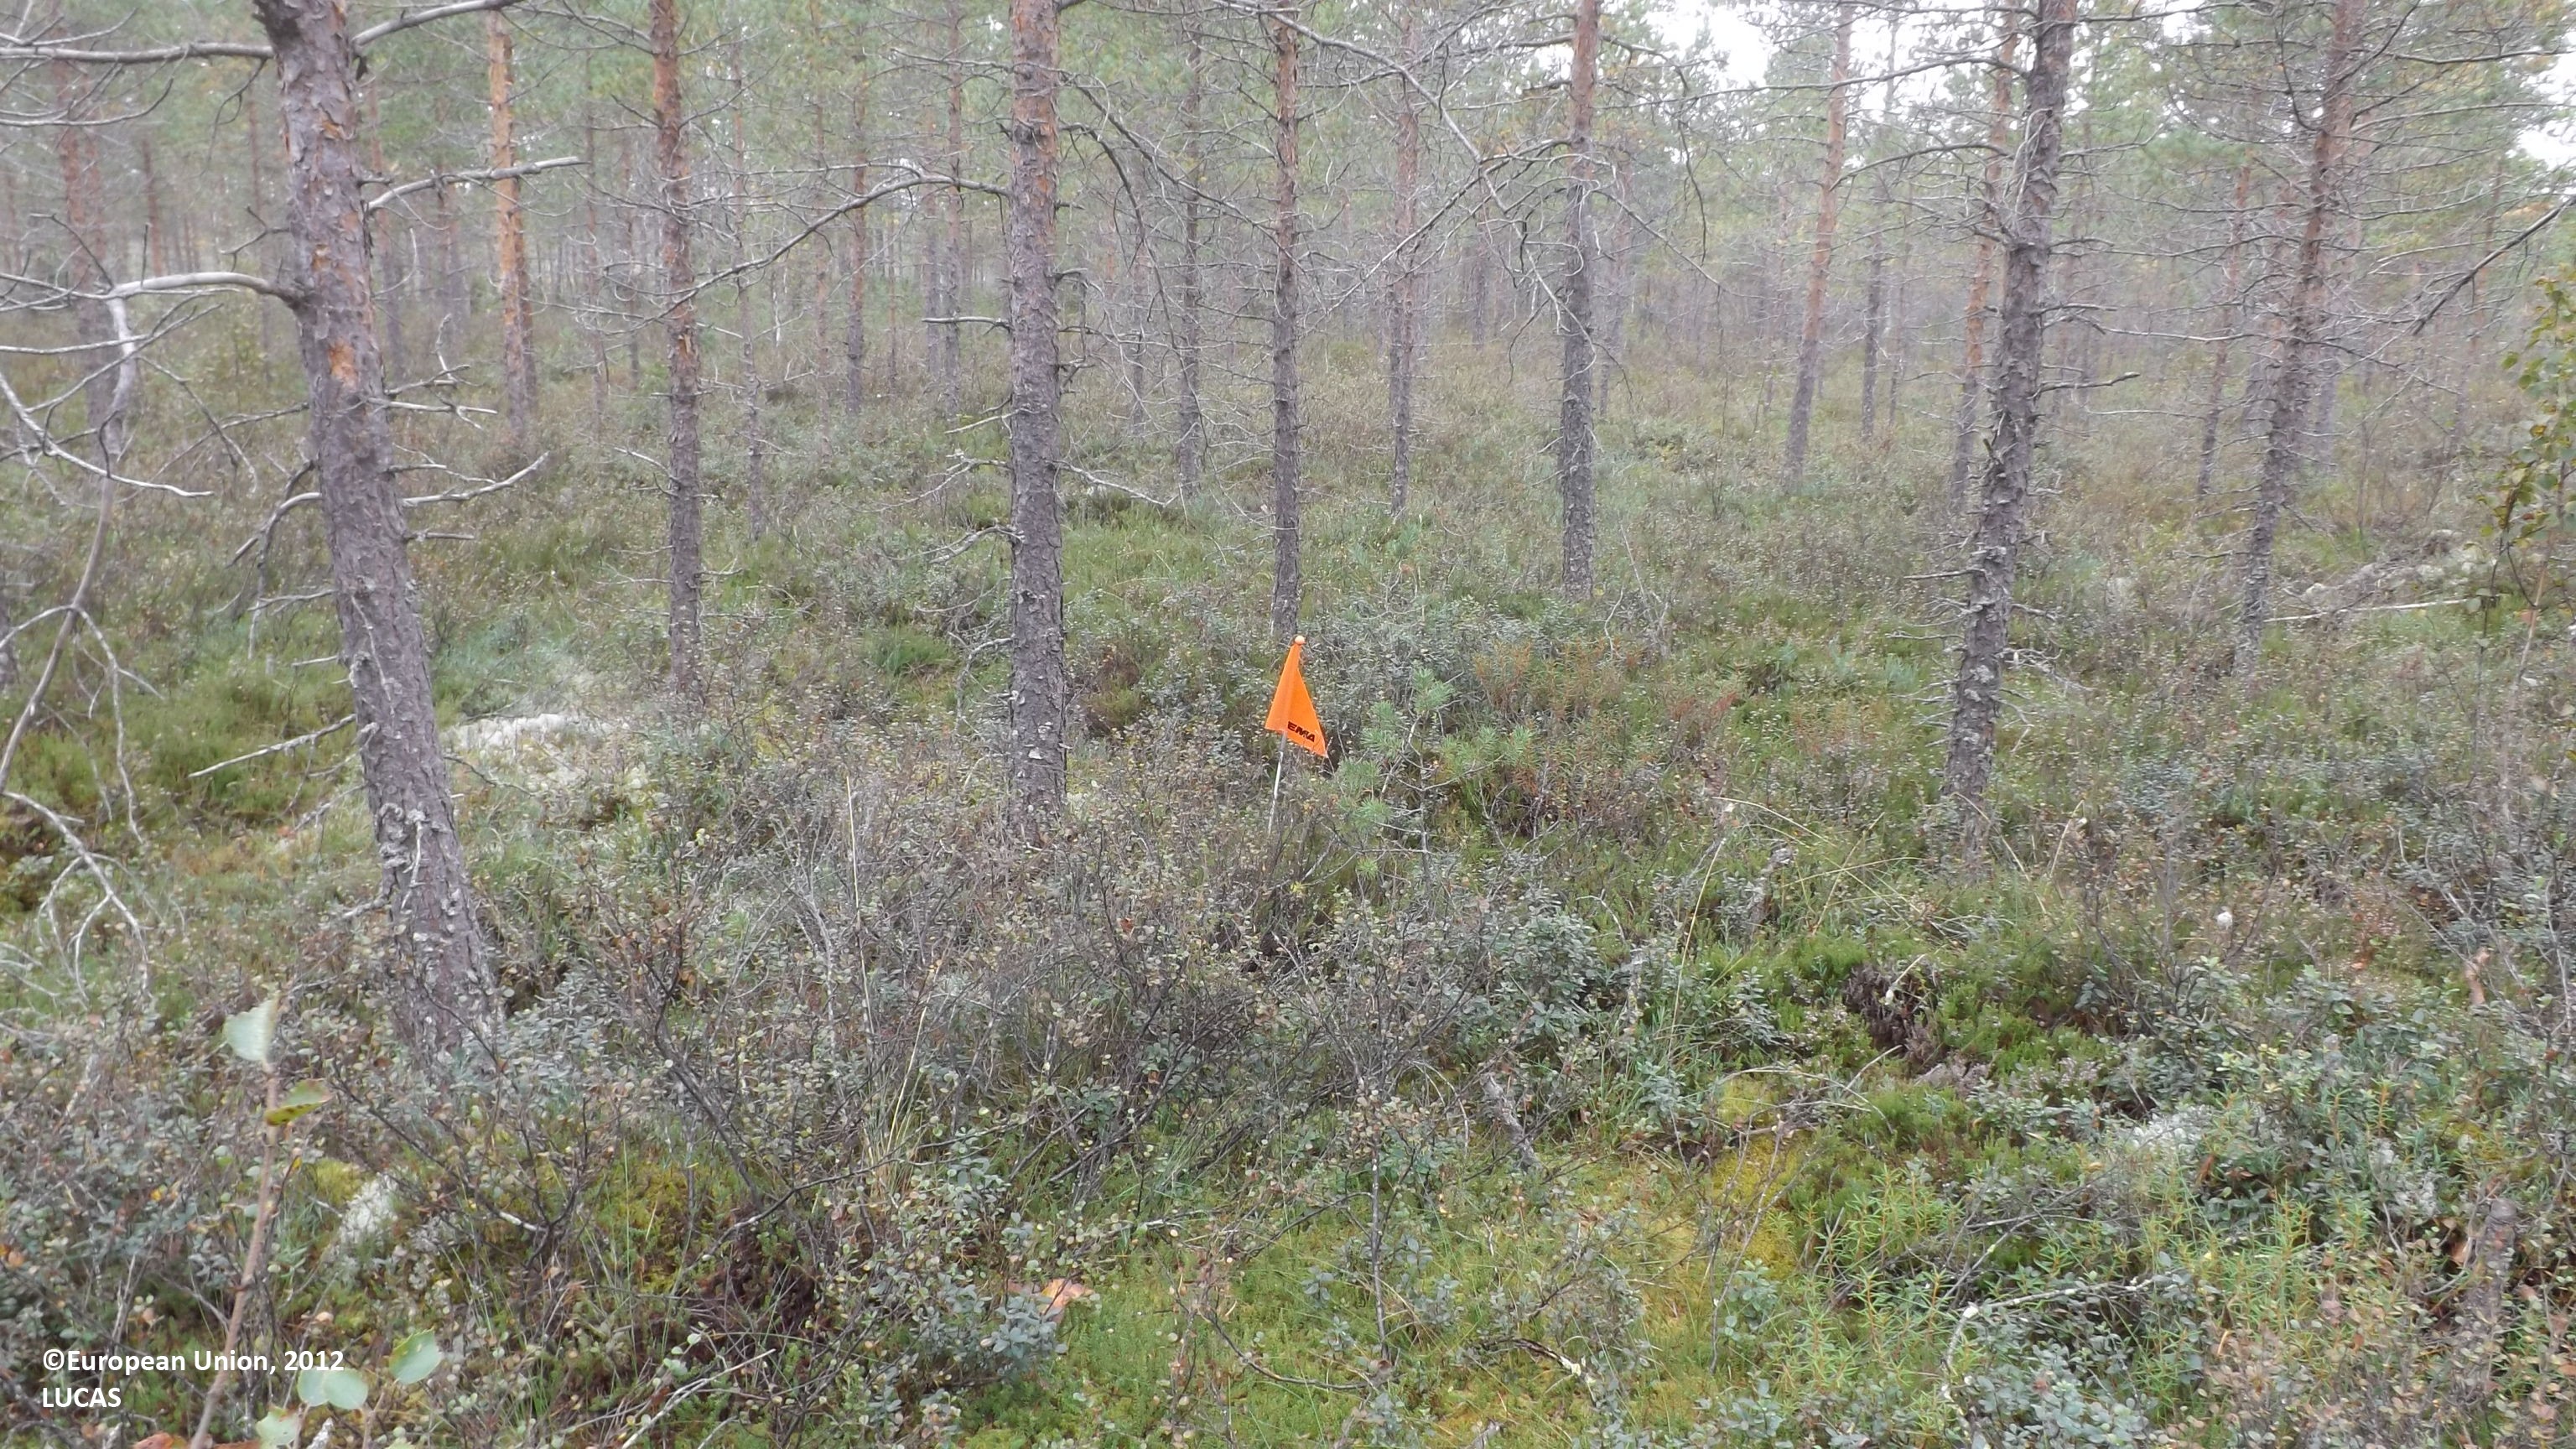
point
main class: Woodland
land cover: Pine dominated coniferous woodland
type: mire and swamp forests
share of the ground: 50 - 75 %
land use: Forestry
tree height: > 5 m
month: August
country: FI
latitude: 63.9251
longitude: 23.9518
